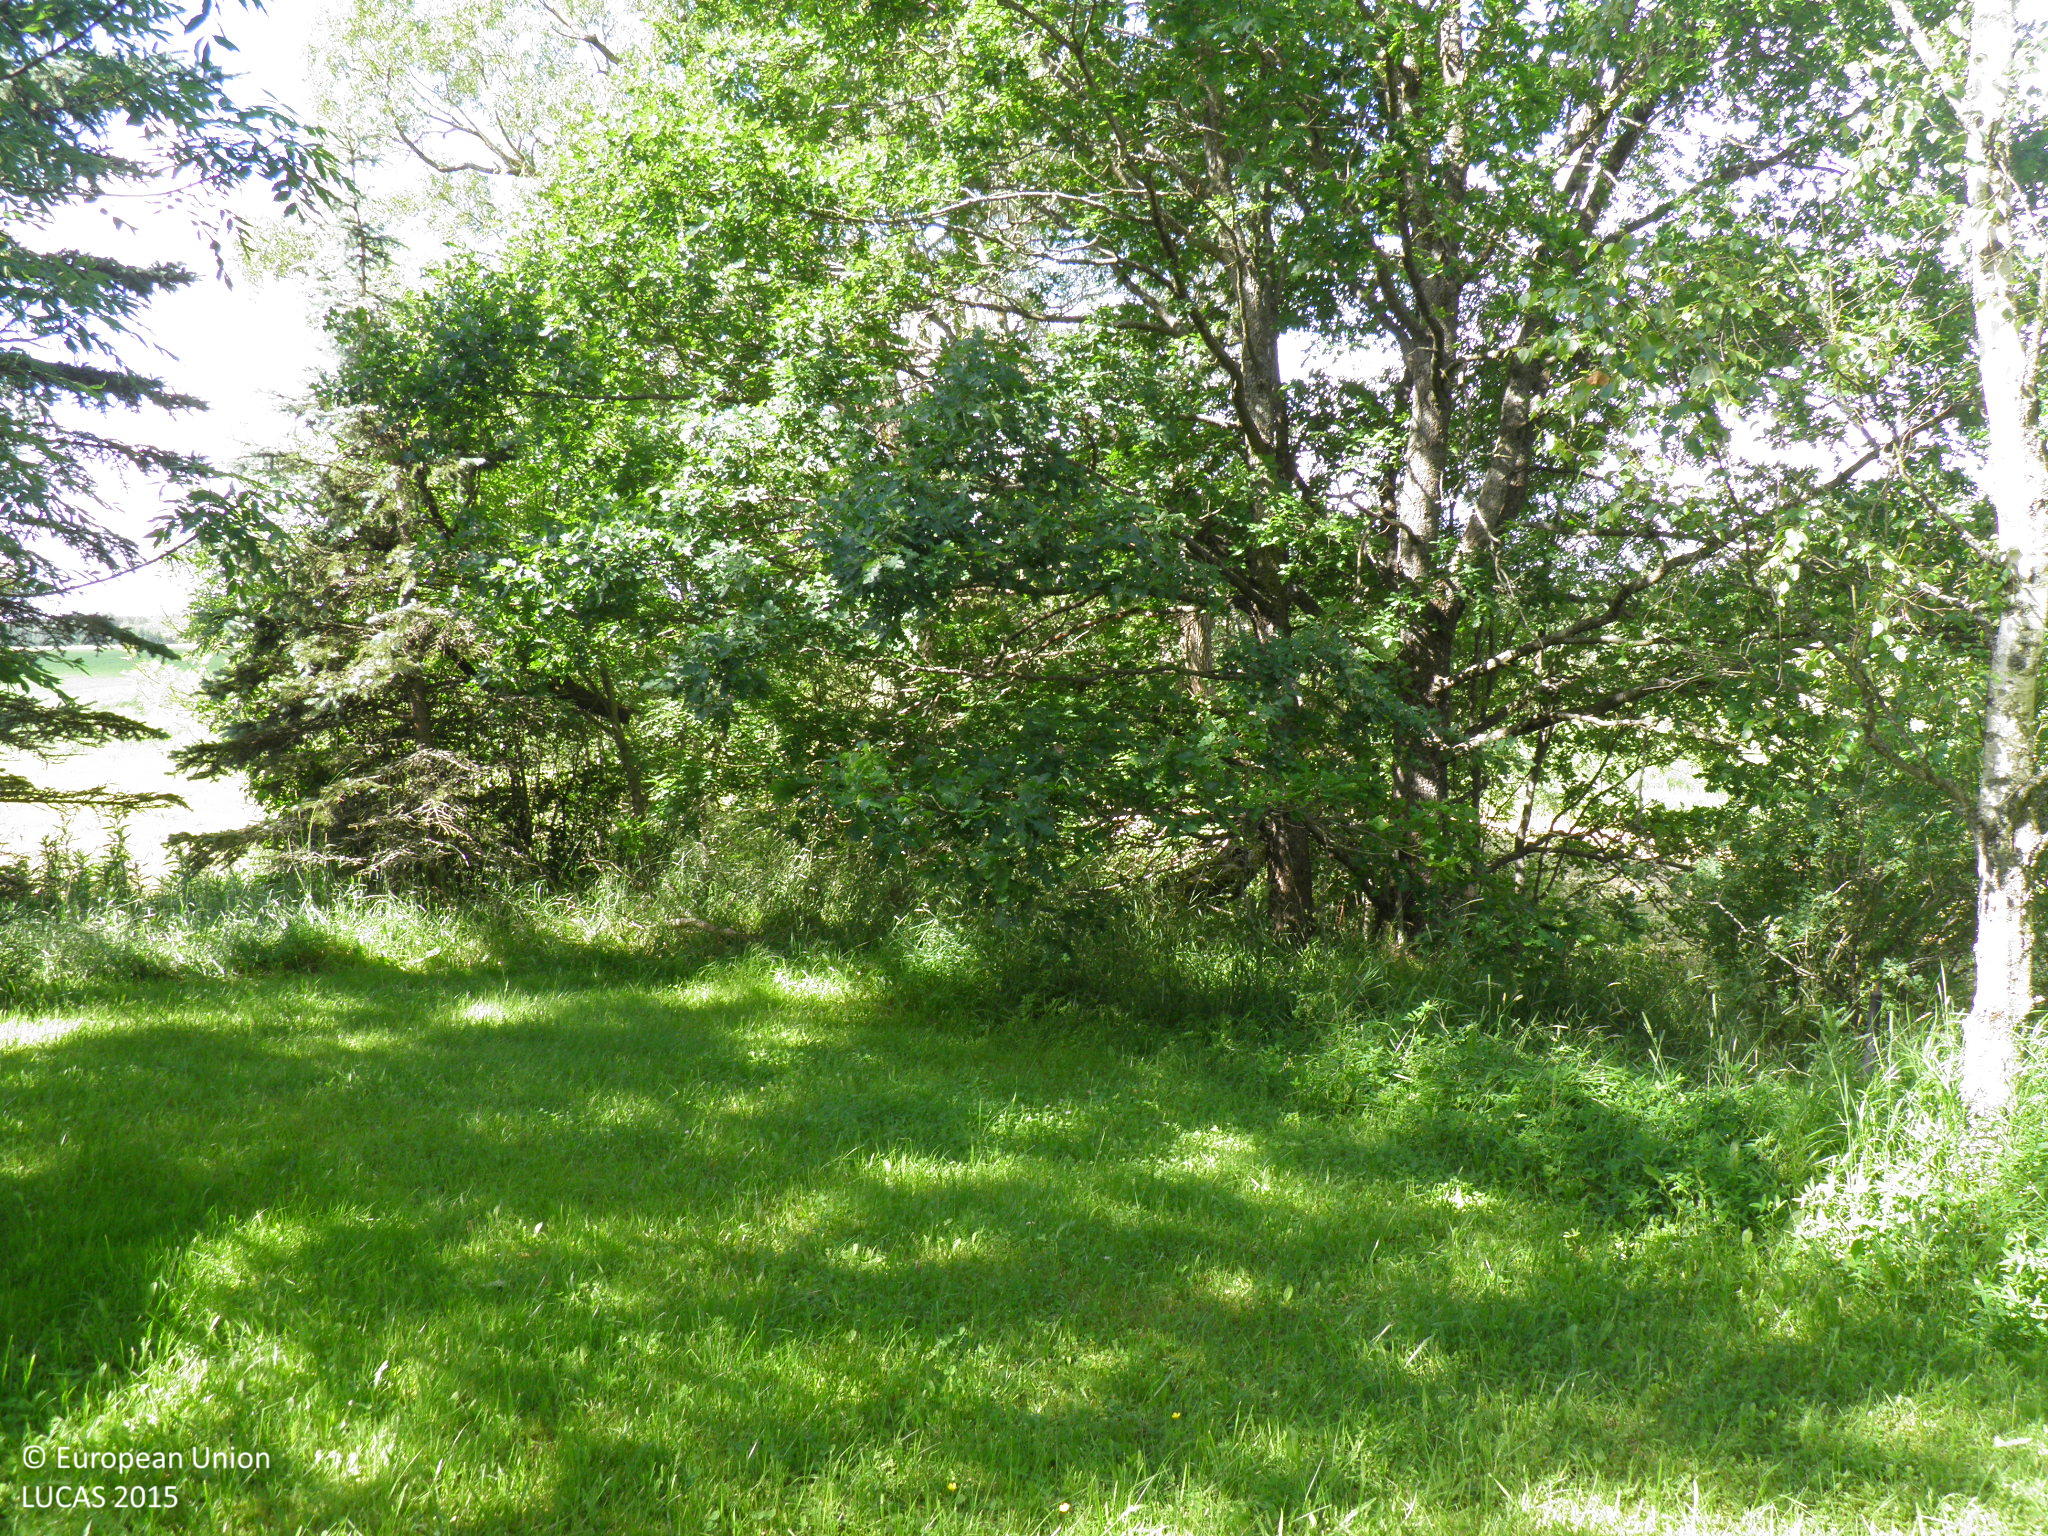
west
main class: Grassland
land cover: Grassland with sparse tree/shrub cover
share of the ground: > 75 %
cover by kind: herbaceous plants 95 %, broadleaved forest trees 5 %
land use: Residential
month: July
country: FI
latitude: 60.7904
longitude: 22.9154
